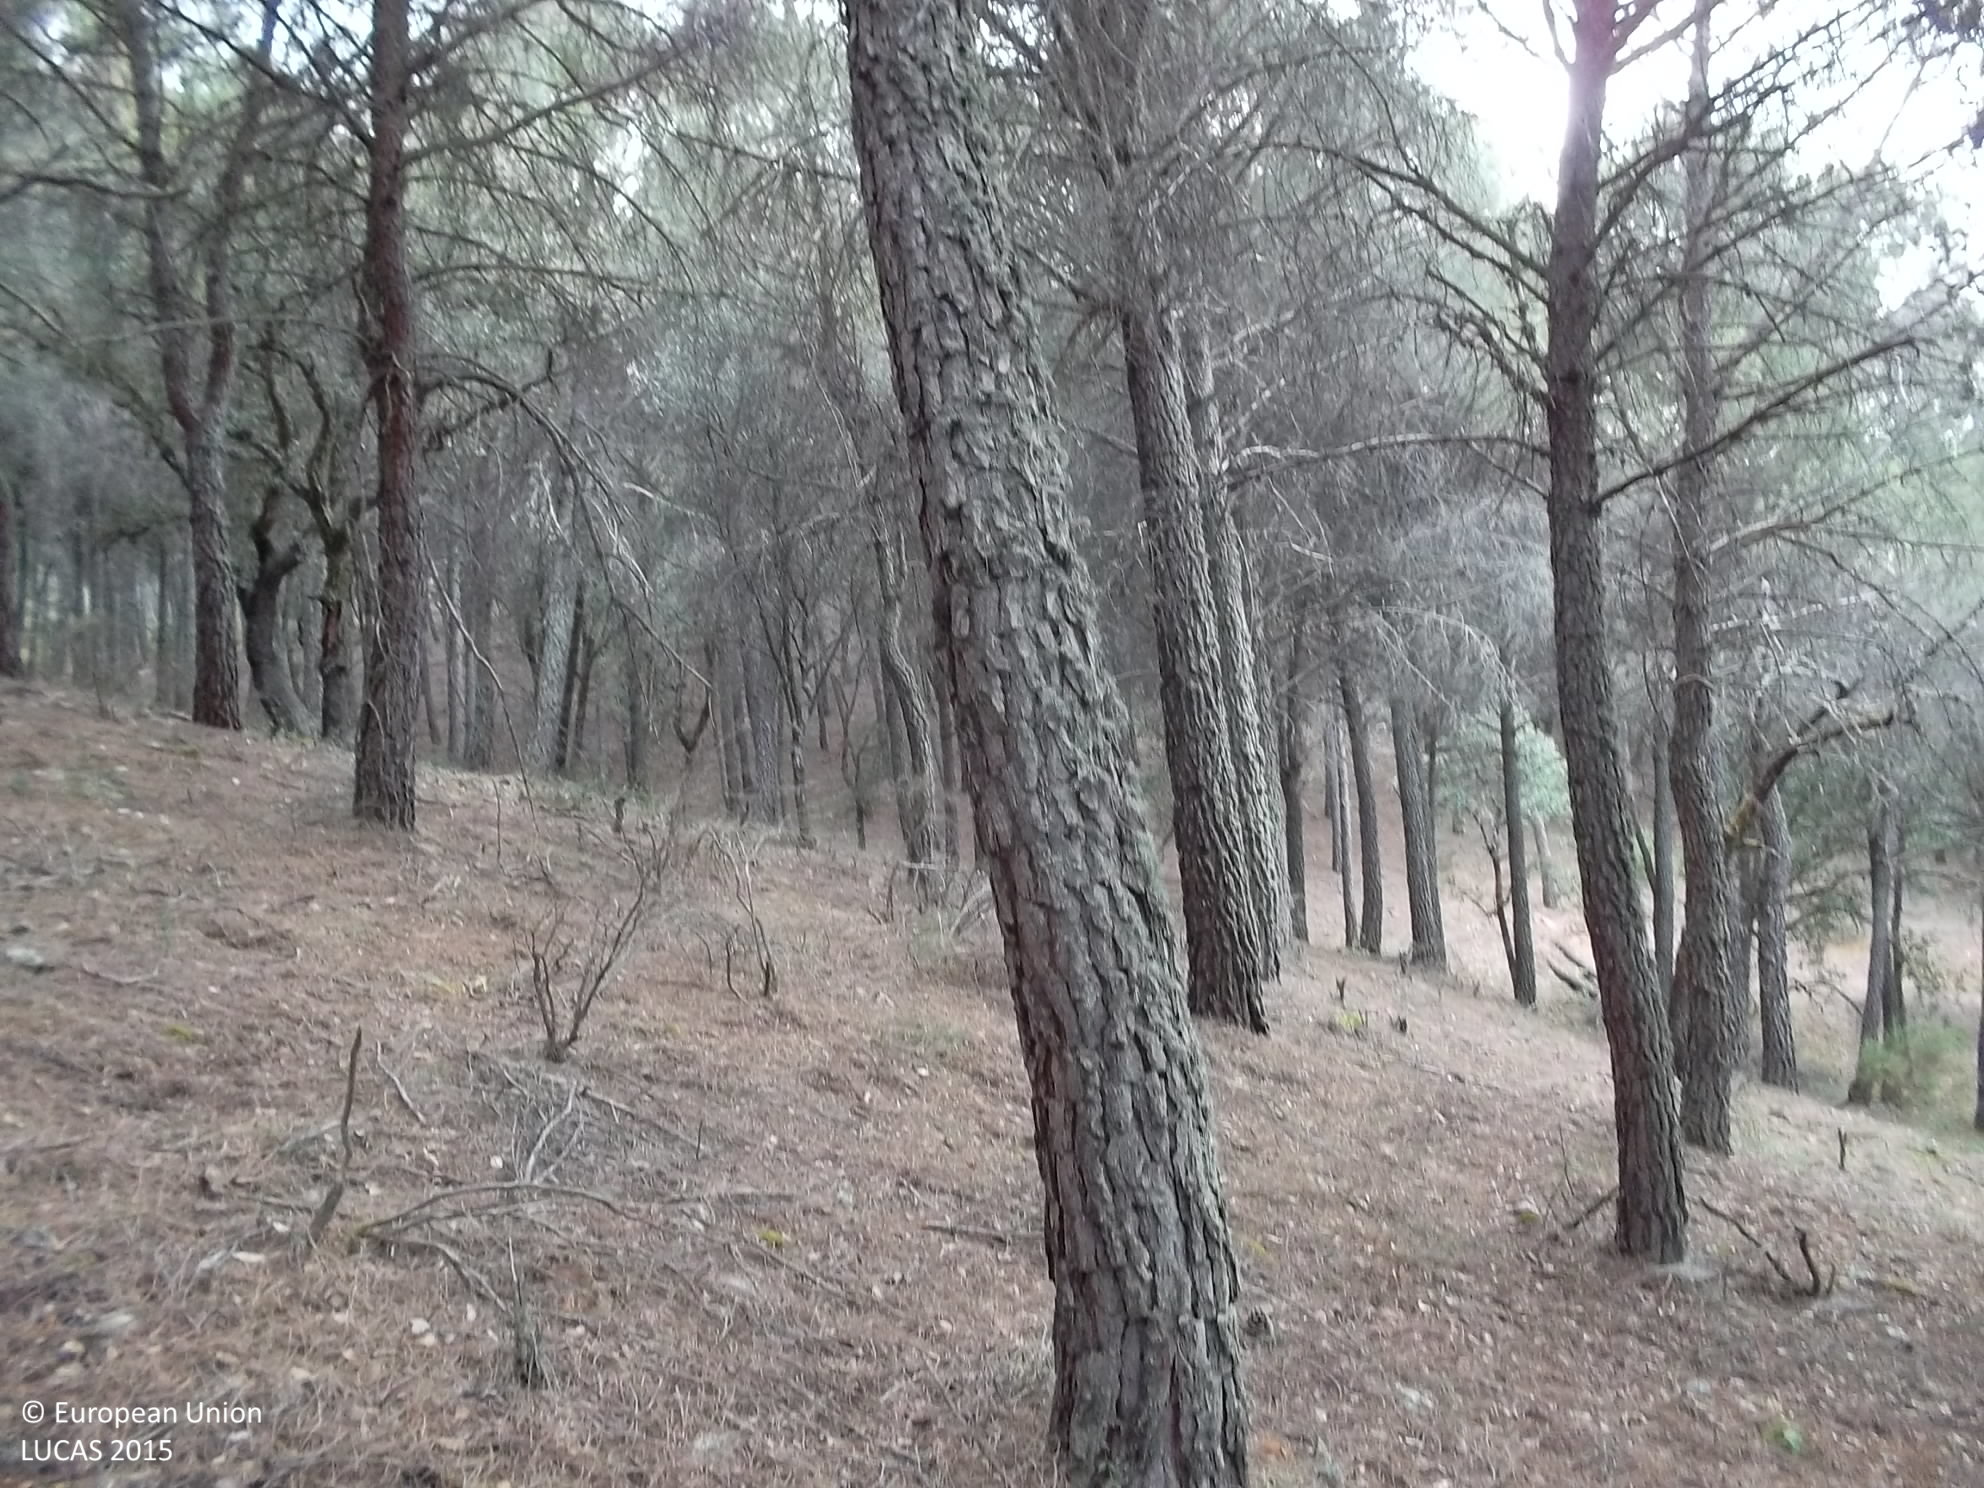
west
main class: Woodland
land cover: Pine dominated coniferous woodland
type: alpine coniferous forest
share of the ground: > 75 %
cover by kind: coniferous forest trees 100 %
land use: Forestry
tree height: > 5 m
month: June
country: ES
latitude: 39.0008
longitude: -4.4964
